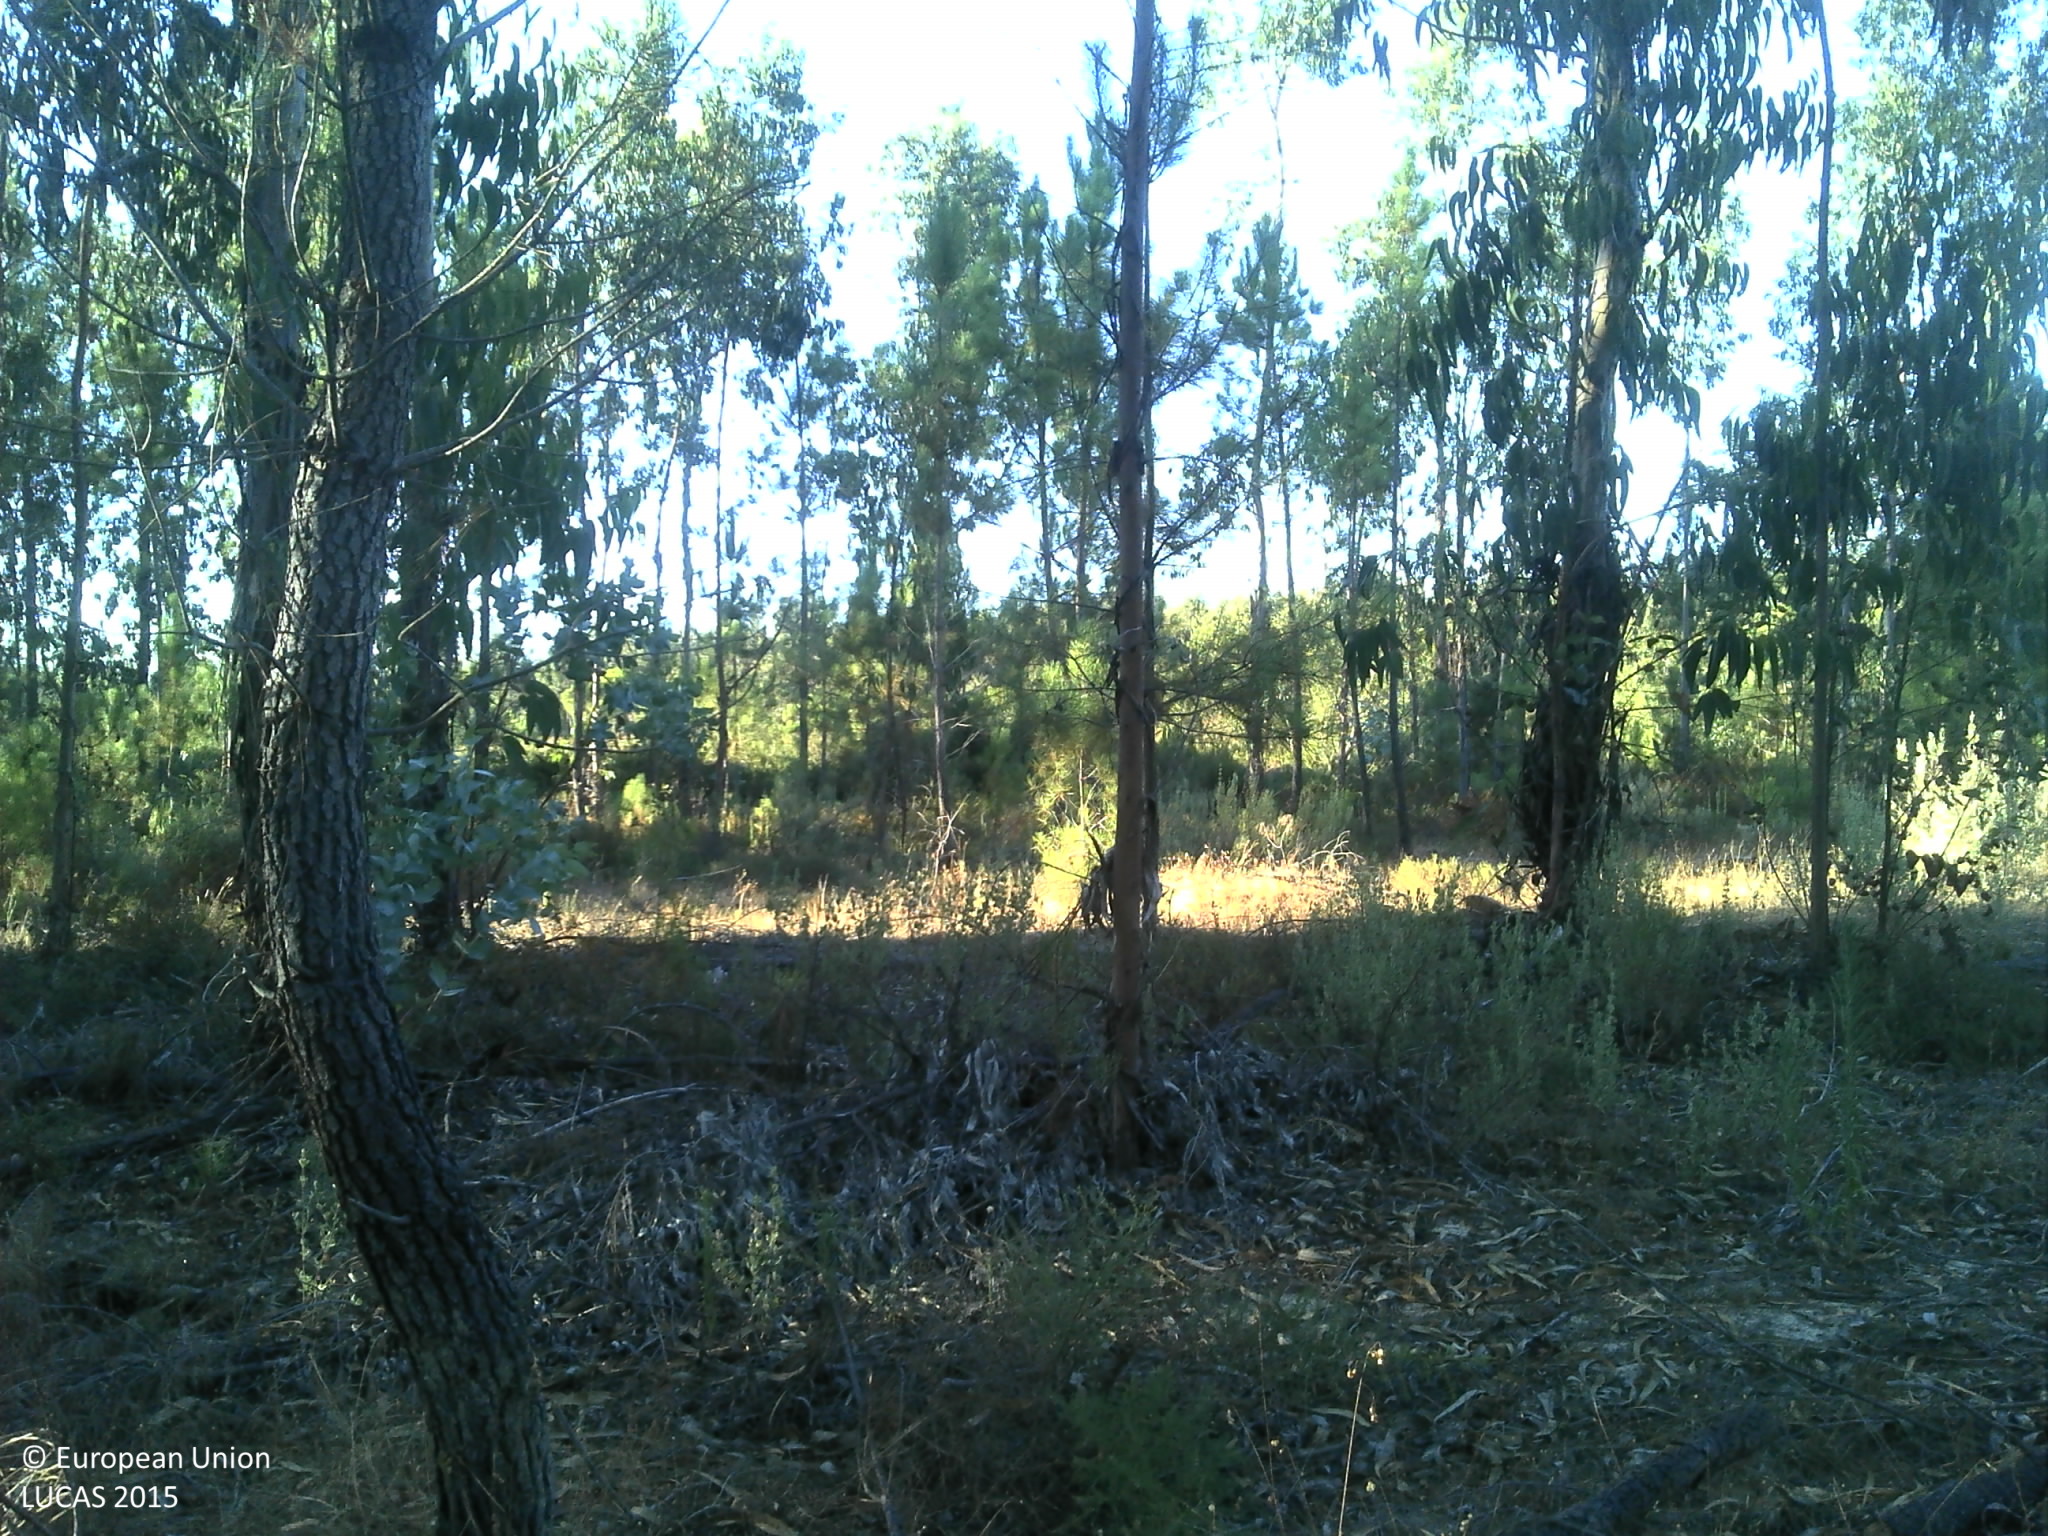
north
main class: Woodland
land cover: Pine dominated mixed woodland
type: coniferous forest of the mediterranean region
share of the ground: 25 - 50 %
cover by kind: coniferous forest trees 45 %, broadleaved forest trees 30 %, herbaceous plants 10 %, unconsolidated bare surface 10 %, shrubs 5 %
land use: Forestry
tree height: > 5 m
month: July
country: PT
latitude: 39.0075
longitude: -8.6952
